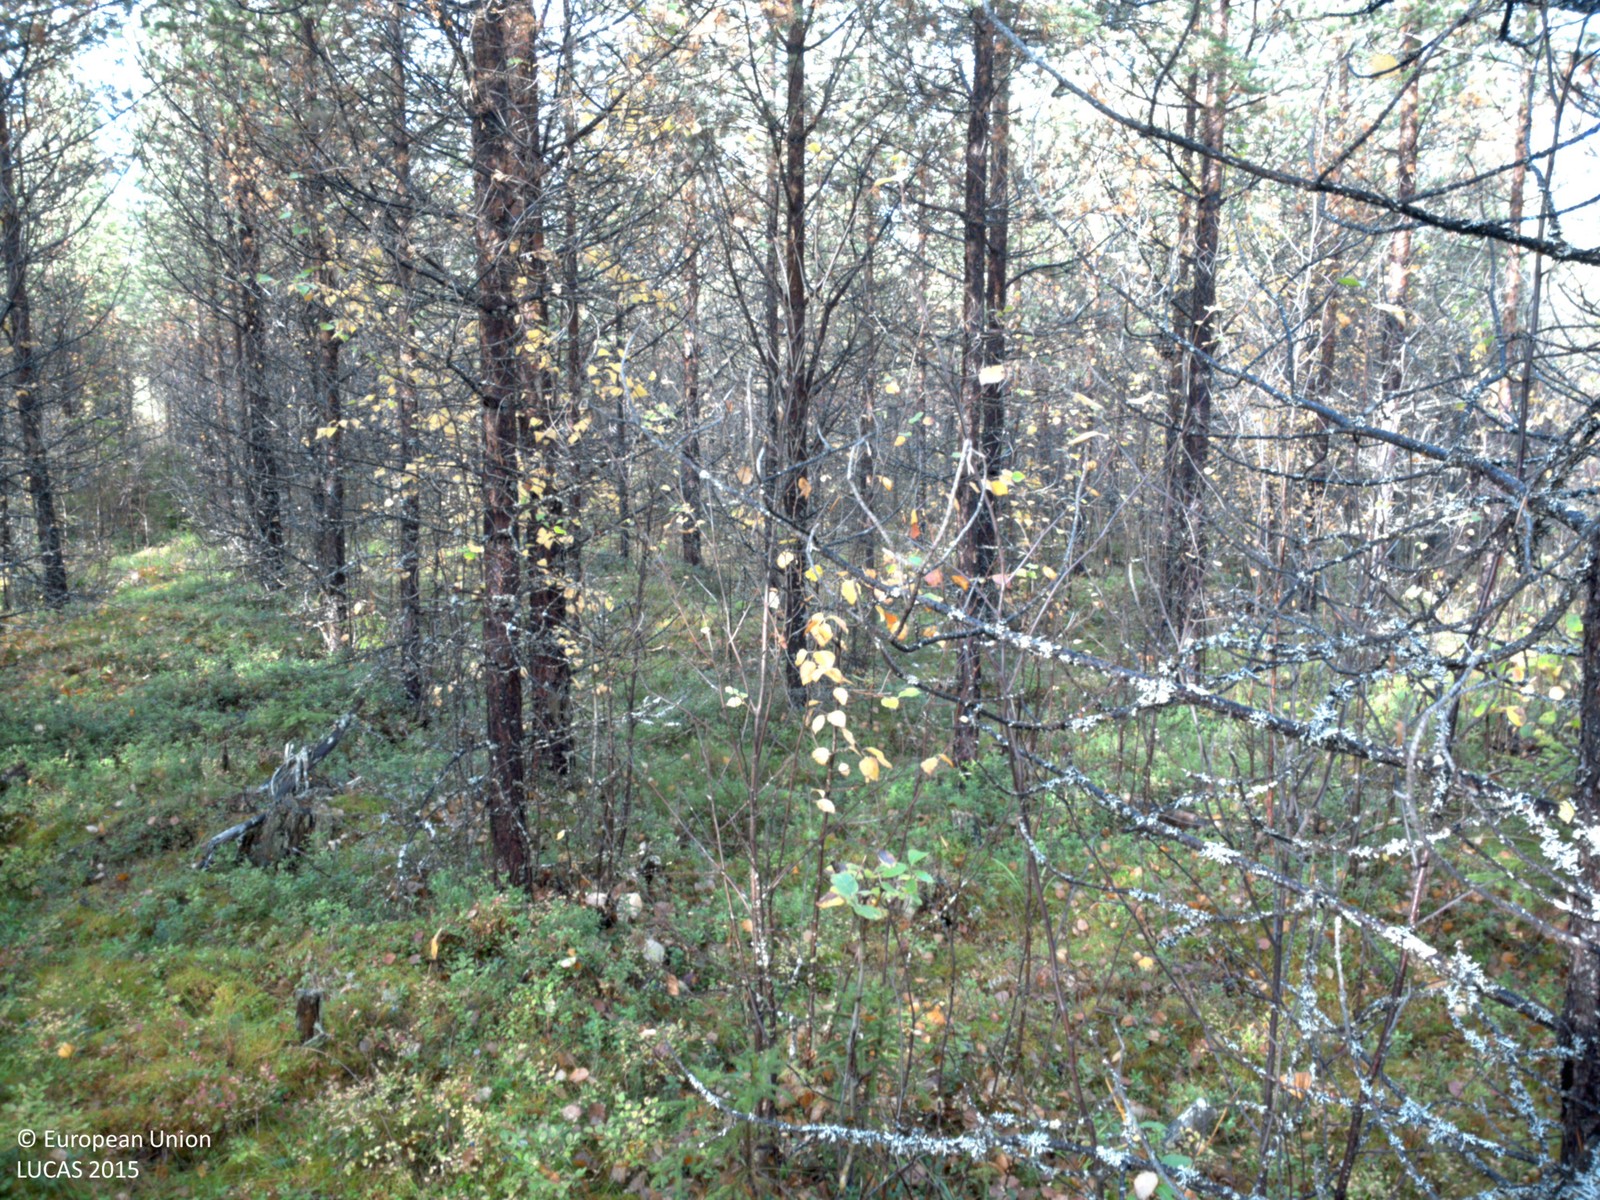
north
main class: Woodland
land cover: Pine dominated coniferous woodland
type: boreal forest
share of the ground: > 75 %
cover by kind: coniferous forest trees 75 %, shrubs 10 %, broadleaved forest trees 5 %, herbaceous plants 5 %, lichens and mosses 5 %
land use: Forestry
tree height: > 5 m
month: September
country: SE
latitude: 64.7215
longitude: 19.0560
